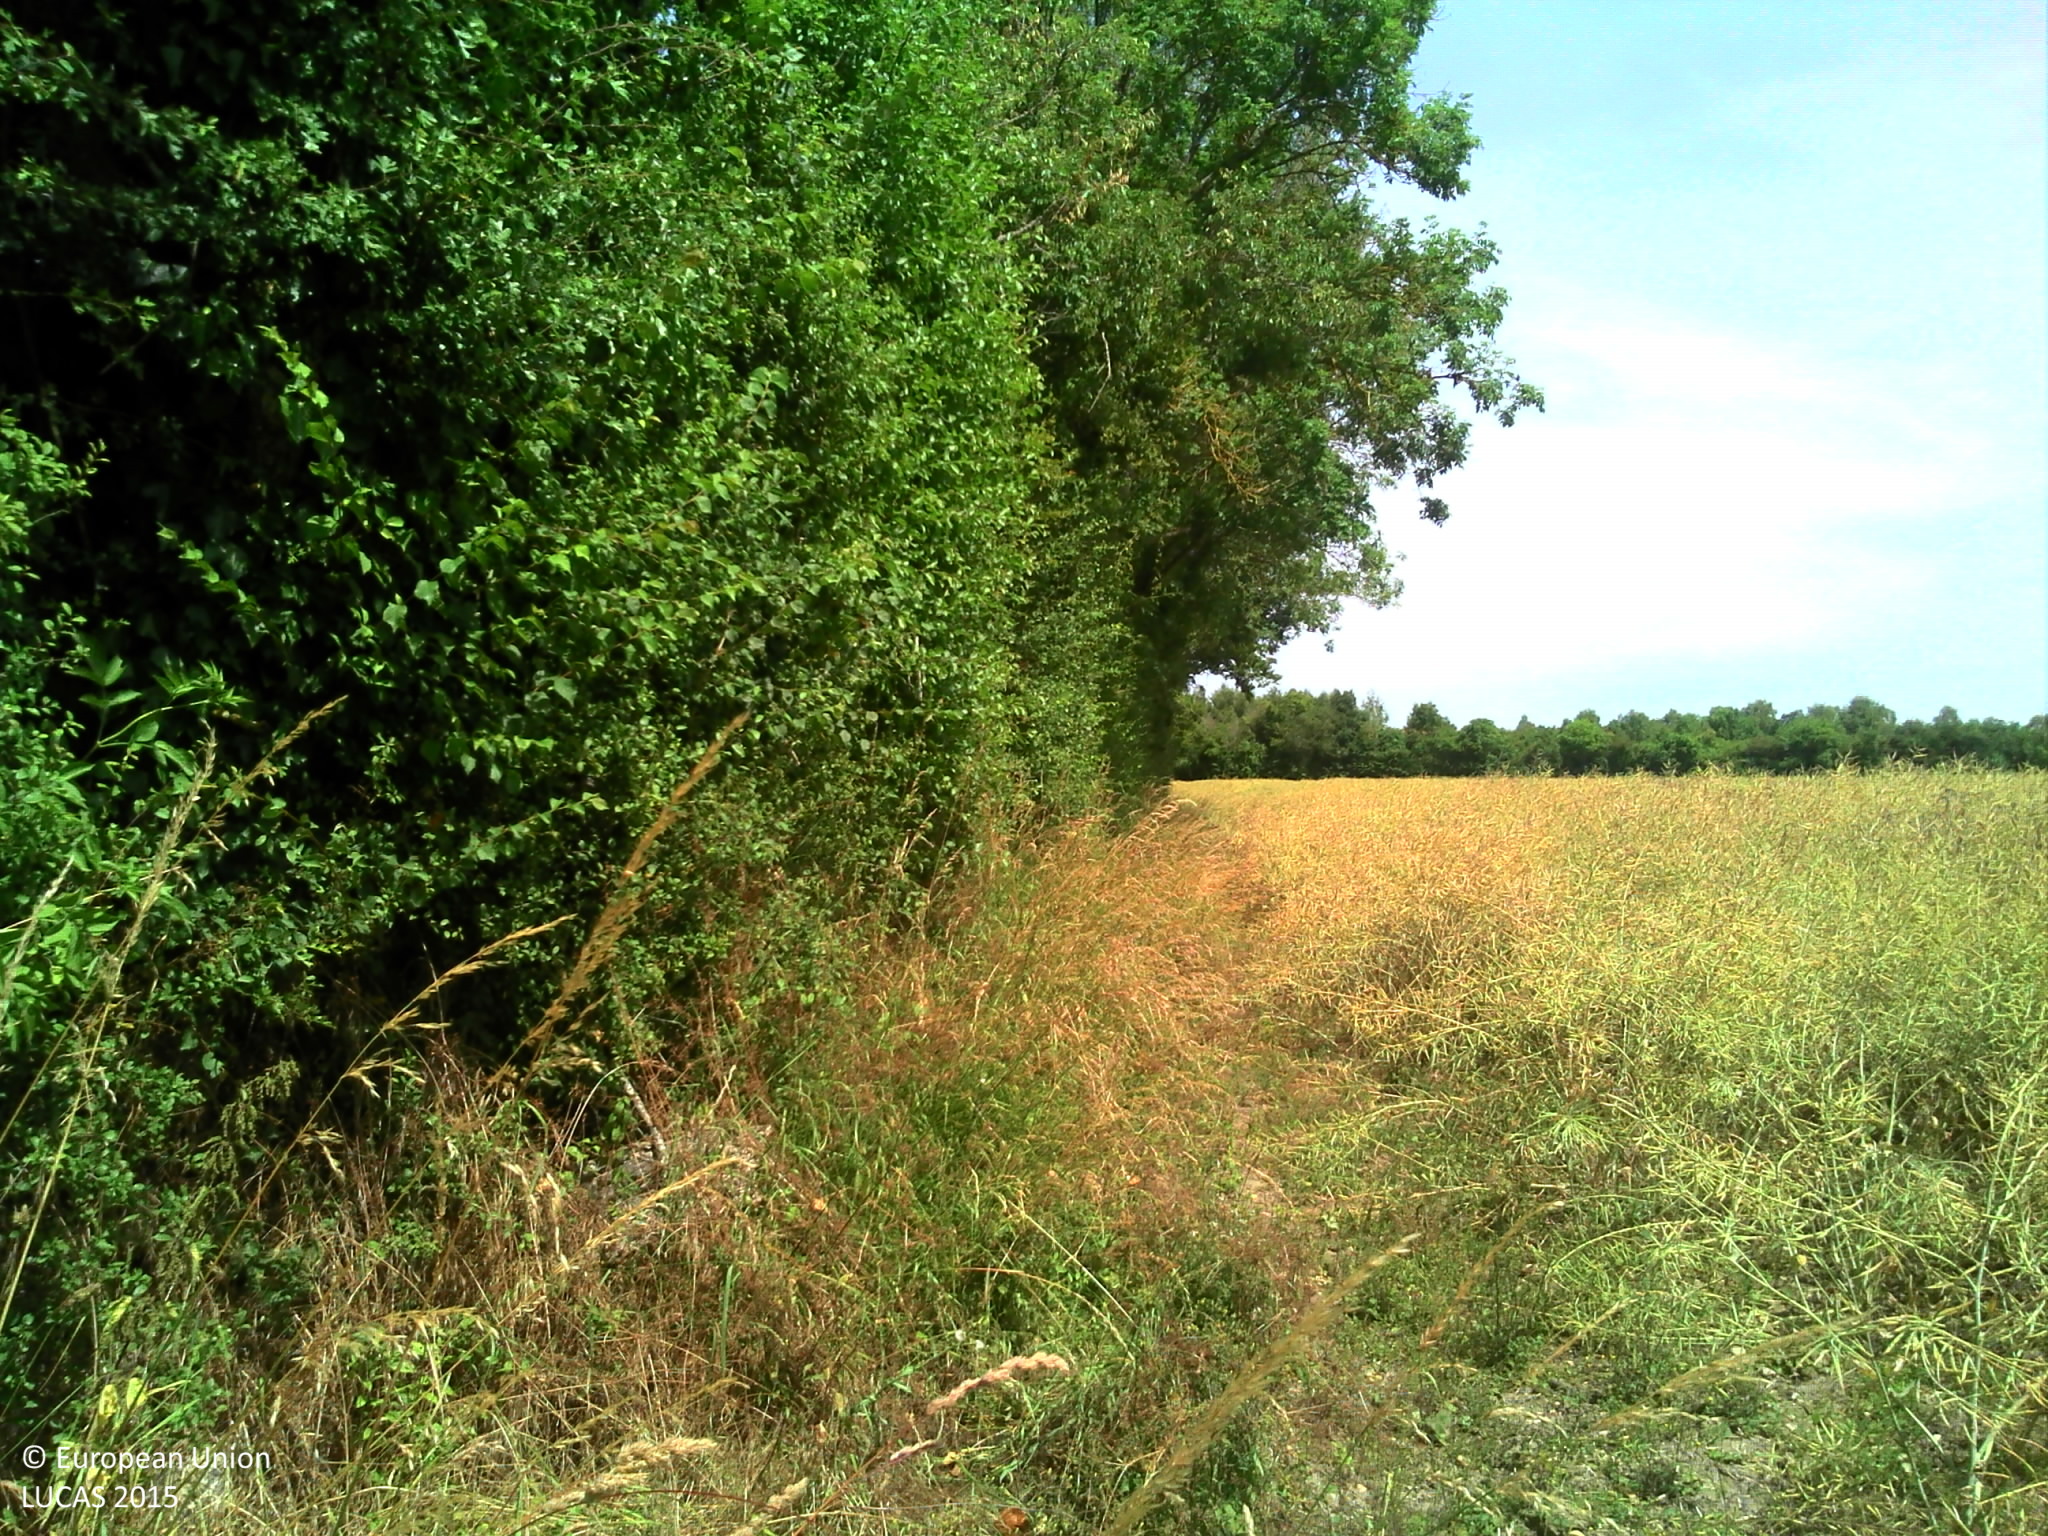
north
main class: Cropland
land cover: Rape and turnip rape
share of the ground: > 75 %
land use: Agriculture (excluding fallow land and kitchen gardens)
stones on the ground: < 10 %
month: June
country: FR
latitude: 47.7712
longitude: 2.8003
